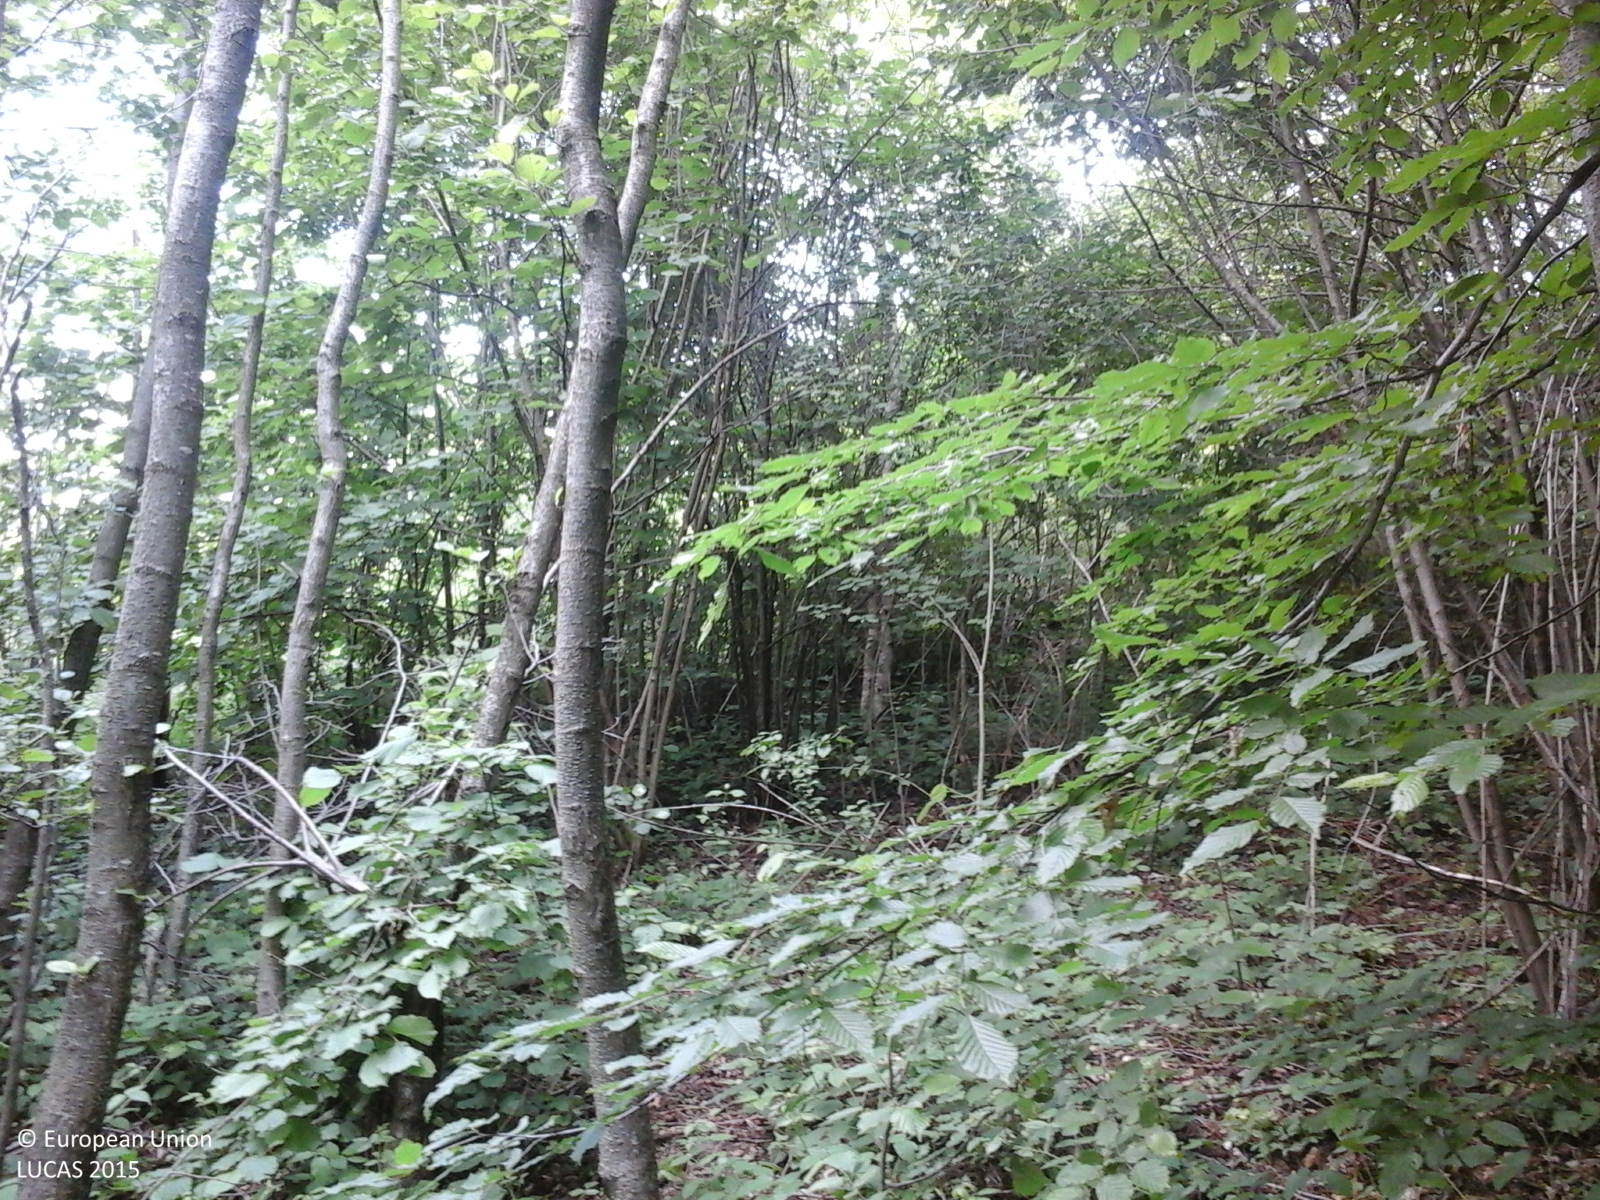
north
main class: Woodland
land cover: Broadleaved woodland
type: beech forest
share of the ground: > 75 %
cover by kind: broadleaved forest trees 100 %
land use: Forestry
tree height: > 5 m
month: May
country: RO
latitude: 45.7968
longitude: 25.2663
